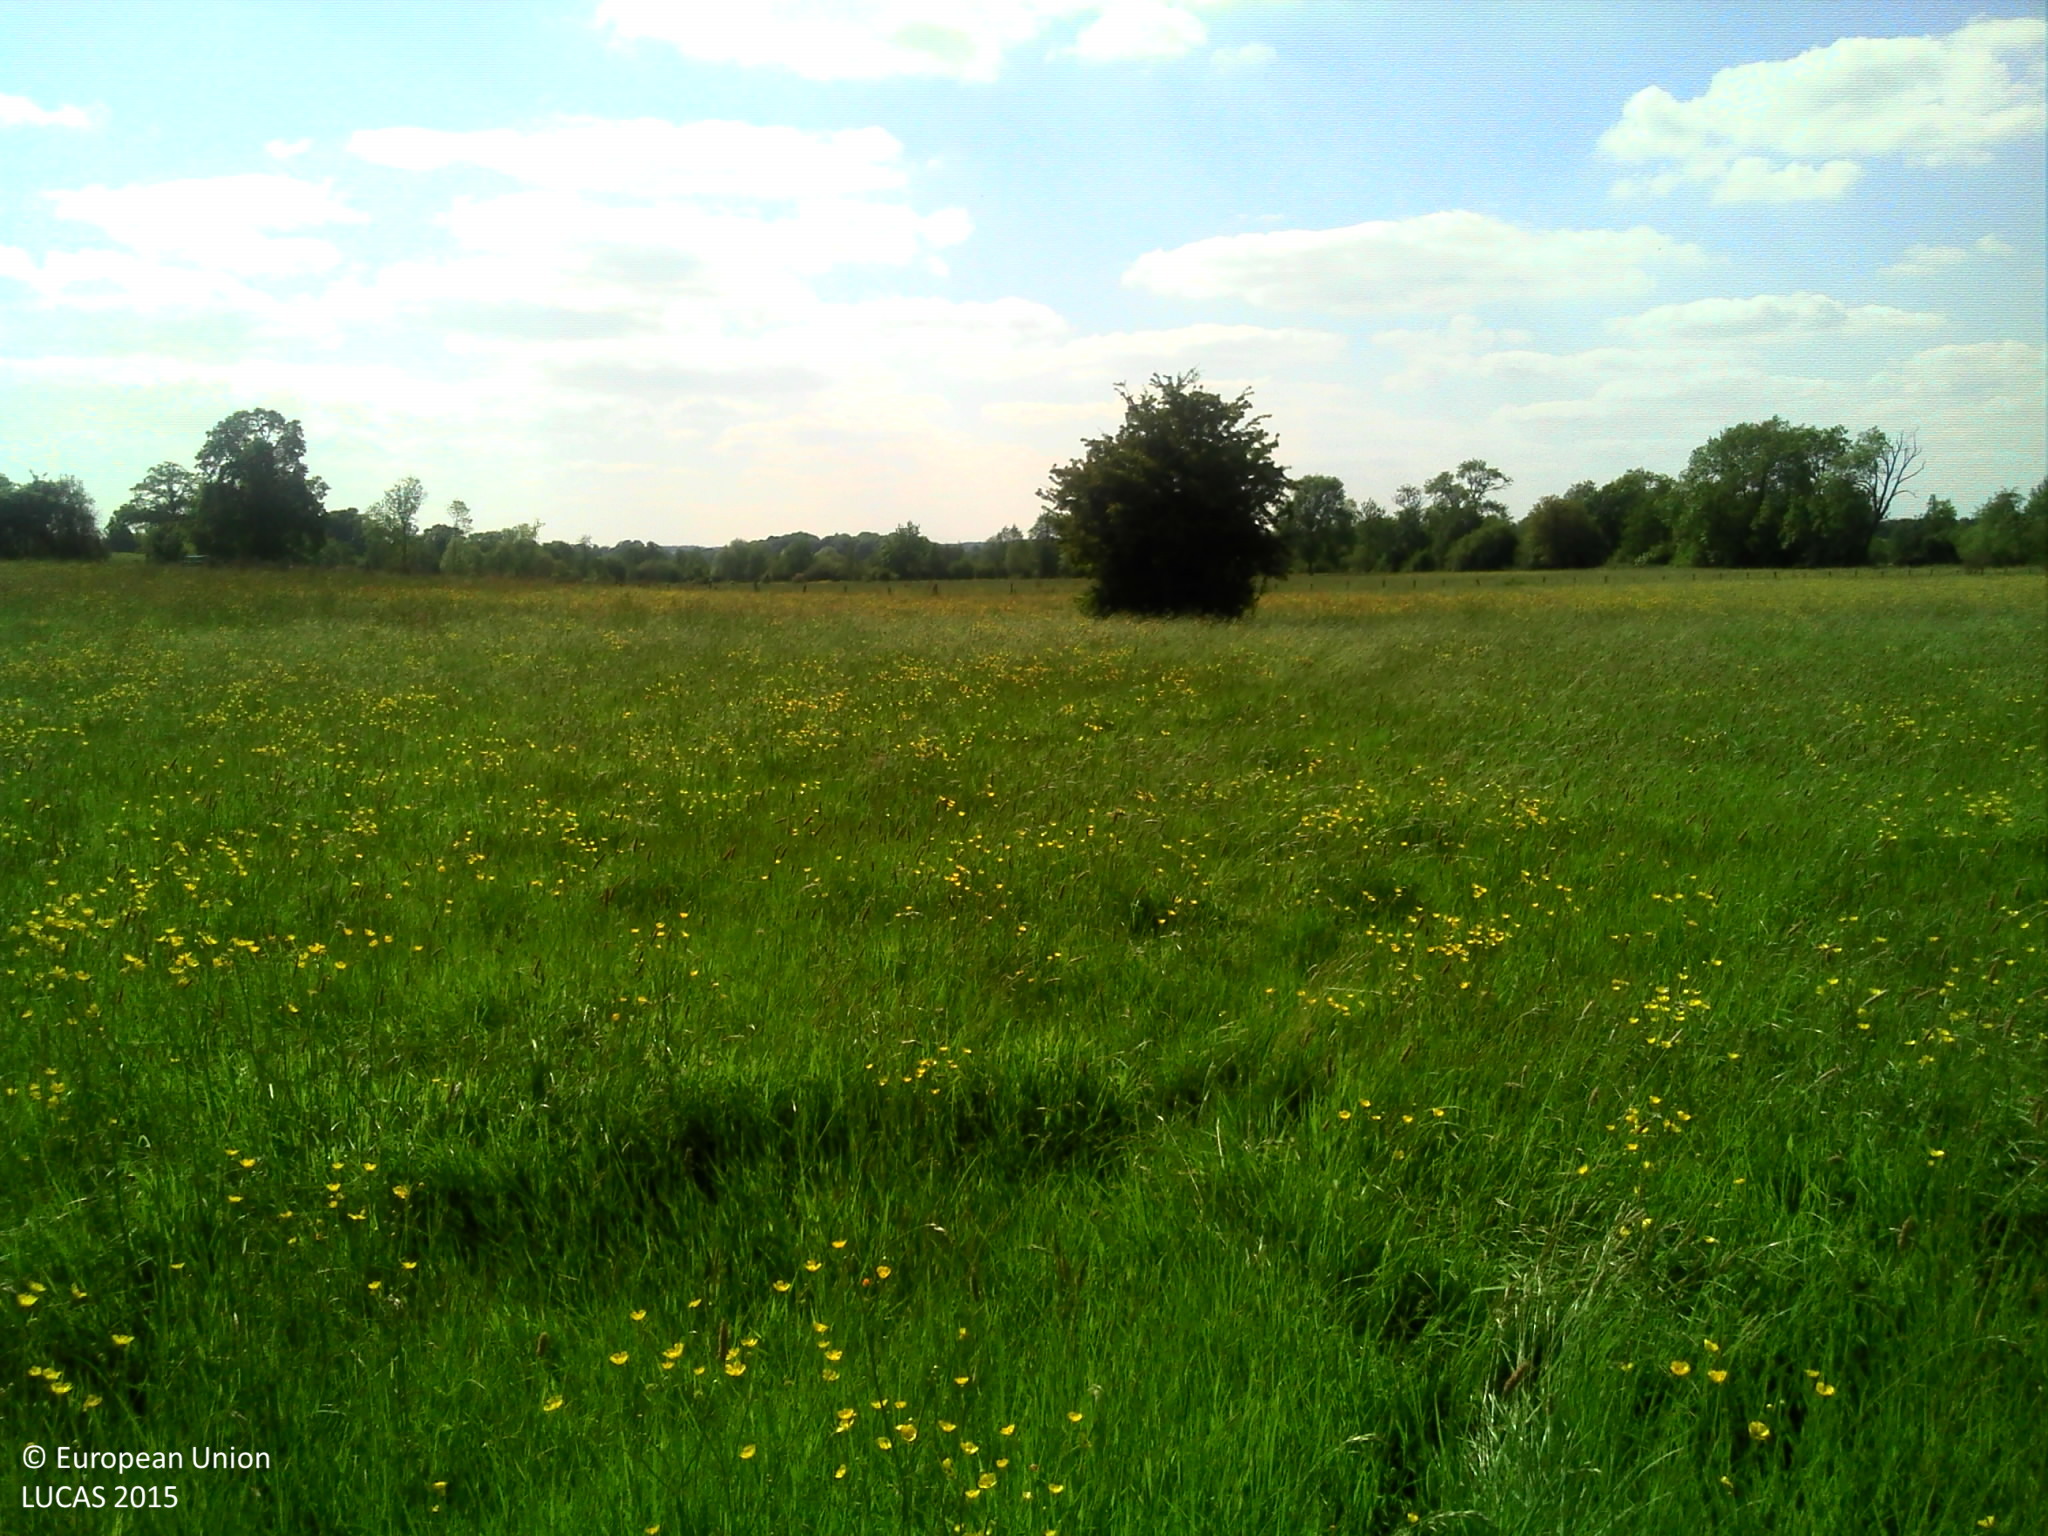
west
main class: Grassland
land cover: Grassland without tree/shrub cover
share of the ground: > 75 %
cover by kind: herbaceous plants 95 %, shrubs 5 %
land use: Agriculture (excluding fallow land and kitchen gardens)
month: May
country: FR
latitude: 48.7167
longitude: -0.1301
